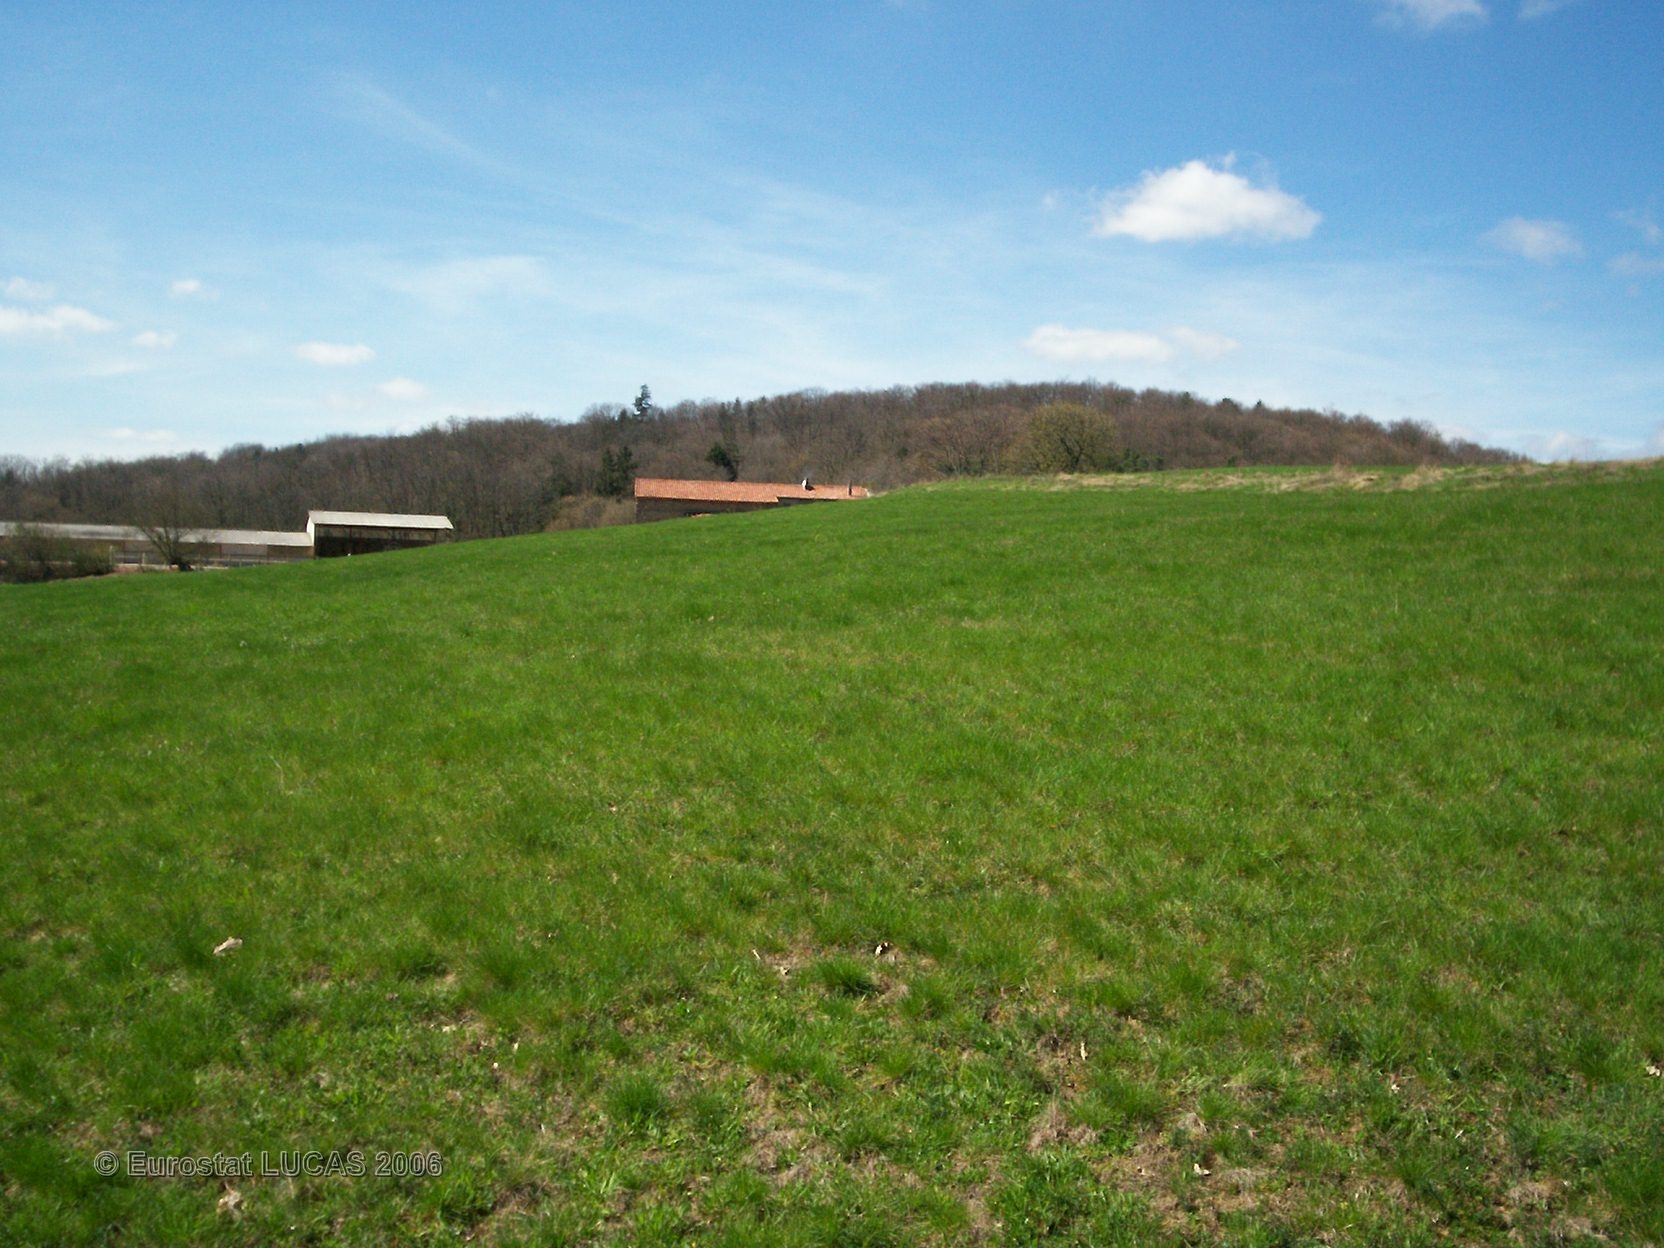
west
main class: Grassland
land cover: Grassland without tree/shrub cover
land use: Agriculture (excluding fallow land and kitchen gardens)
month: April
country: FR
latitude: 46.4379
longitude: 4.7306
